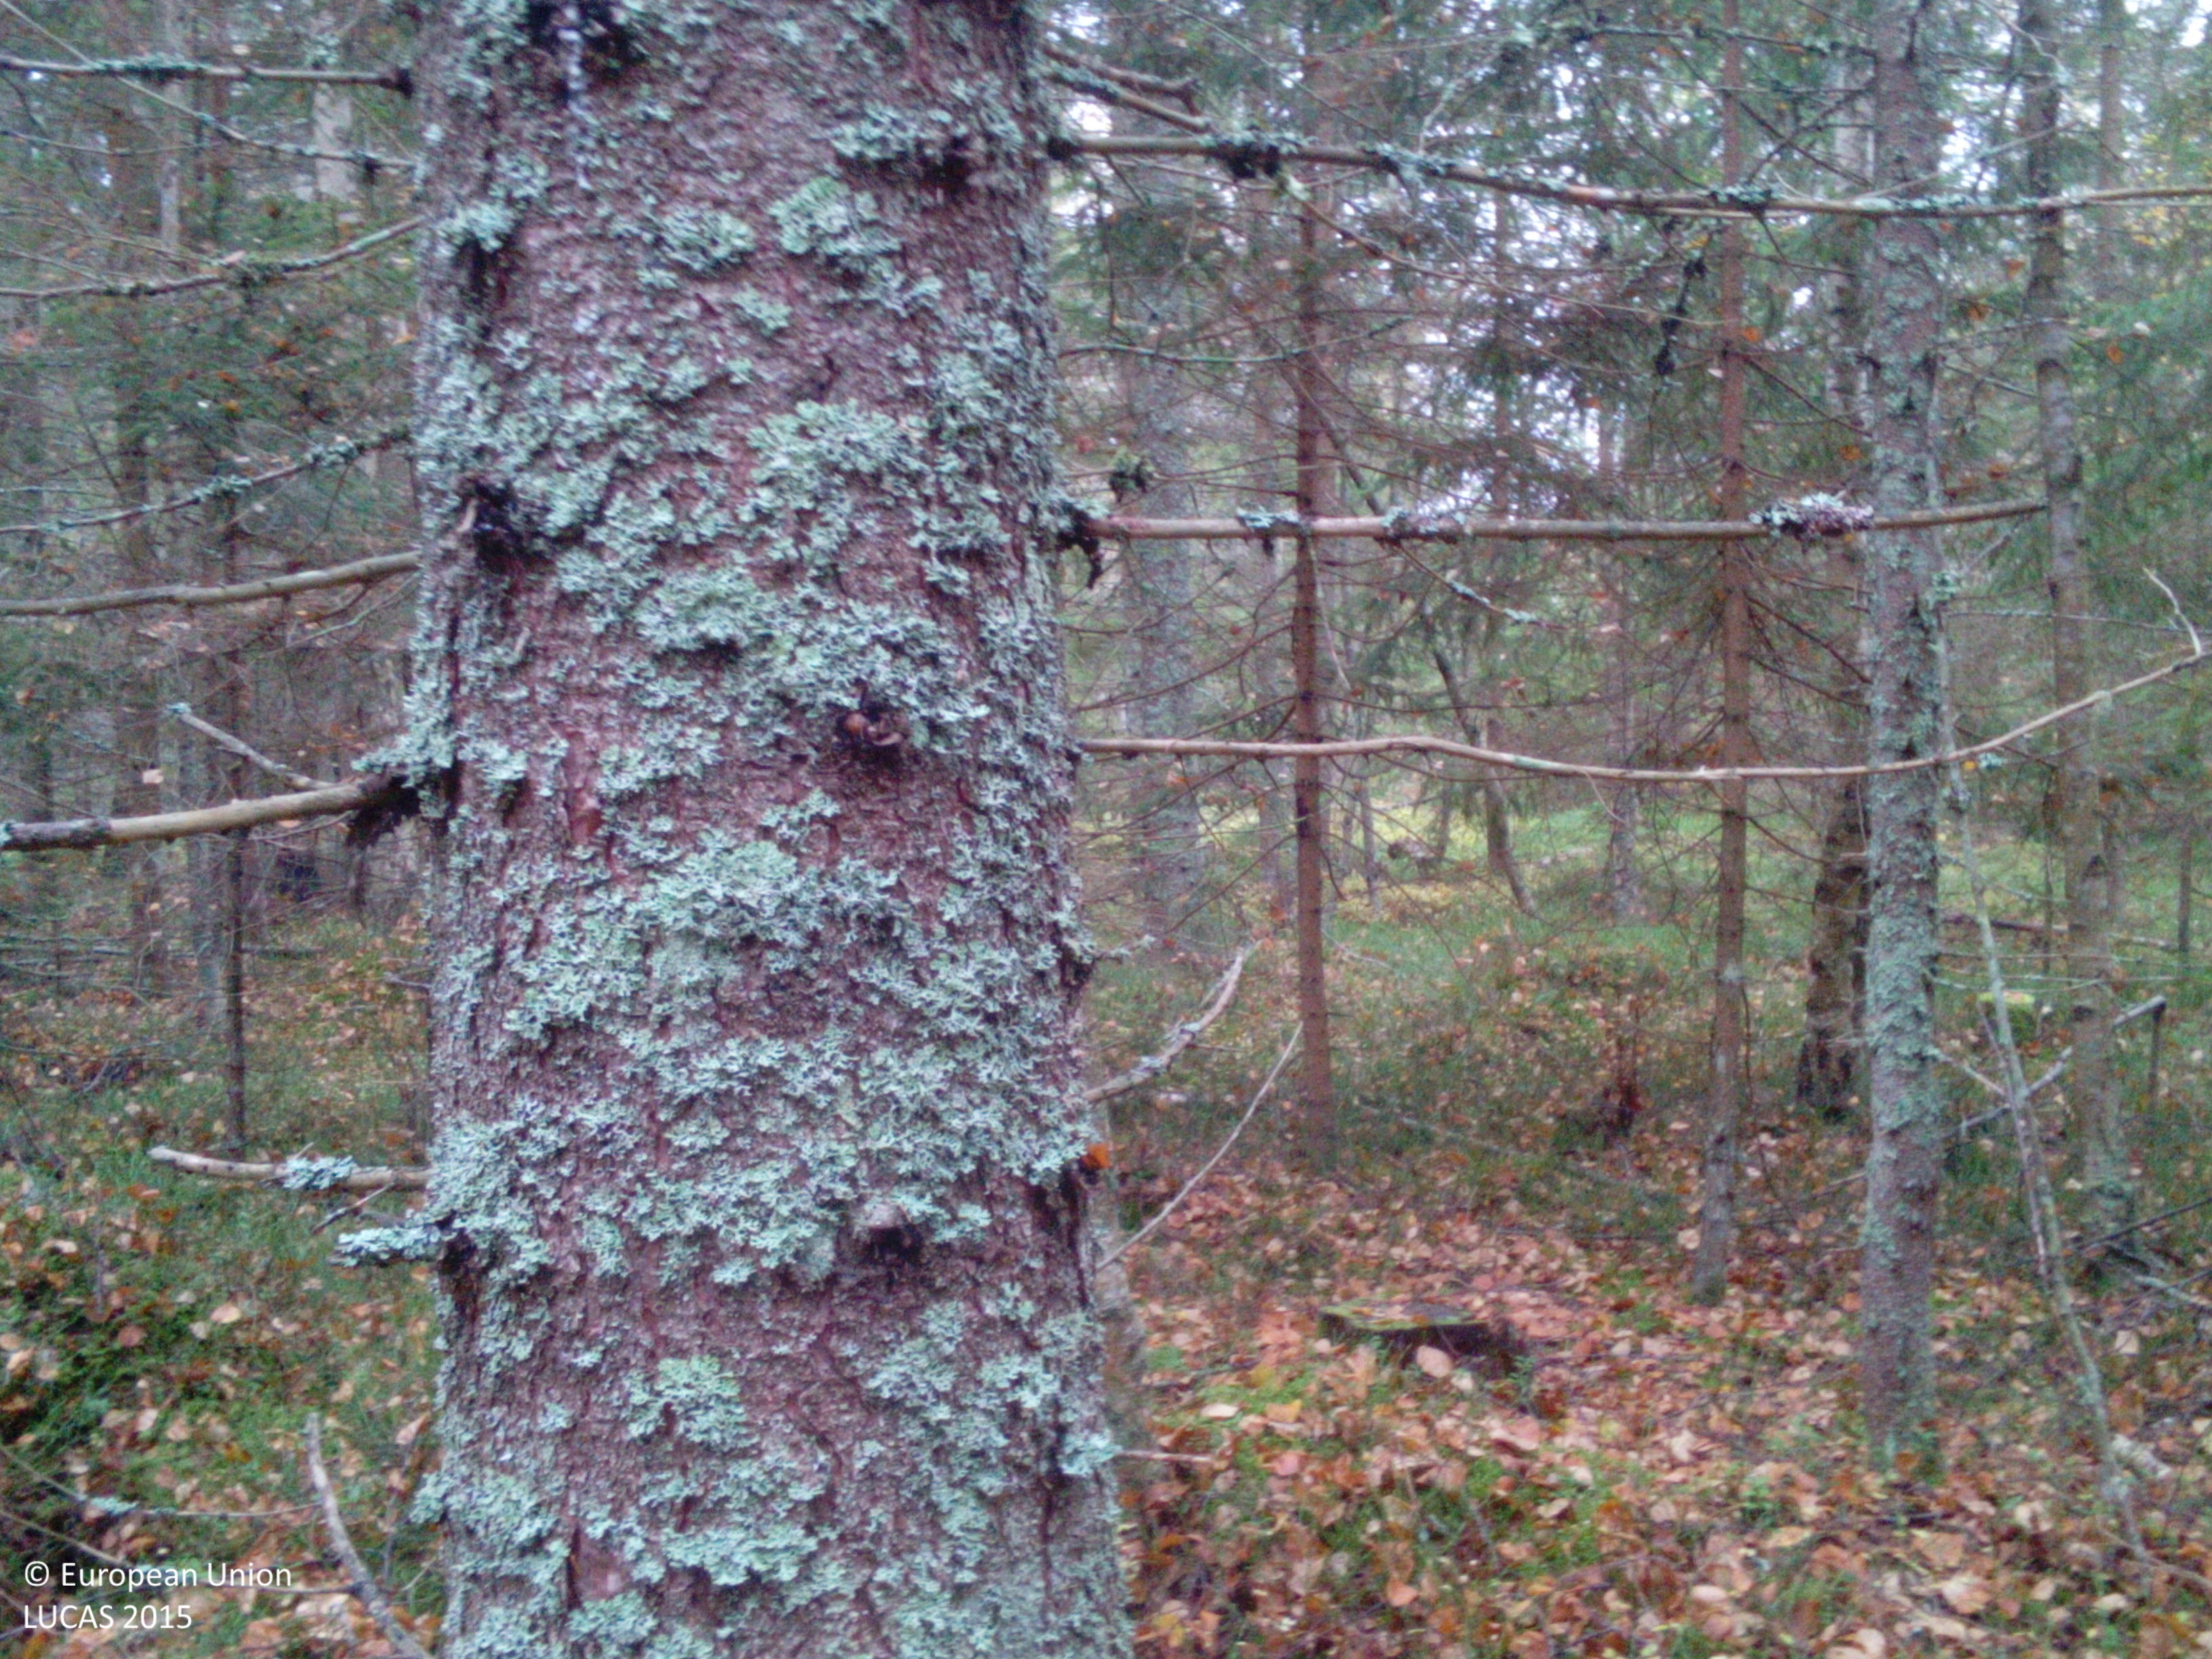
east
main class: Woodland
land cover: Spruce dominated mixed woodland
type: boreal forest
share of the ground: > 75 %
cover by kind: coniferous forest trees 45 %, broadleaved forest trees 40 %, lichens and mosses 10 %, herbaceous plants 5 %
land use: Forestry
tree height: > 5 m
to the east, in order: Spruce dominated mixed woodland; Spruce dominated coniferous woodland; Ditches and canals; Grassland with sparse tree/shrub cover; Spruce dominated coniferous woodland; Tracks; Spruce dominated coniferous woodland
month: October
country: SE
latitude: 59.1057
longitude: 16.1920
